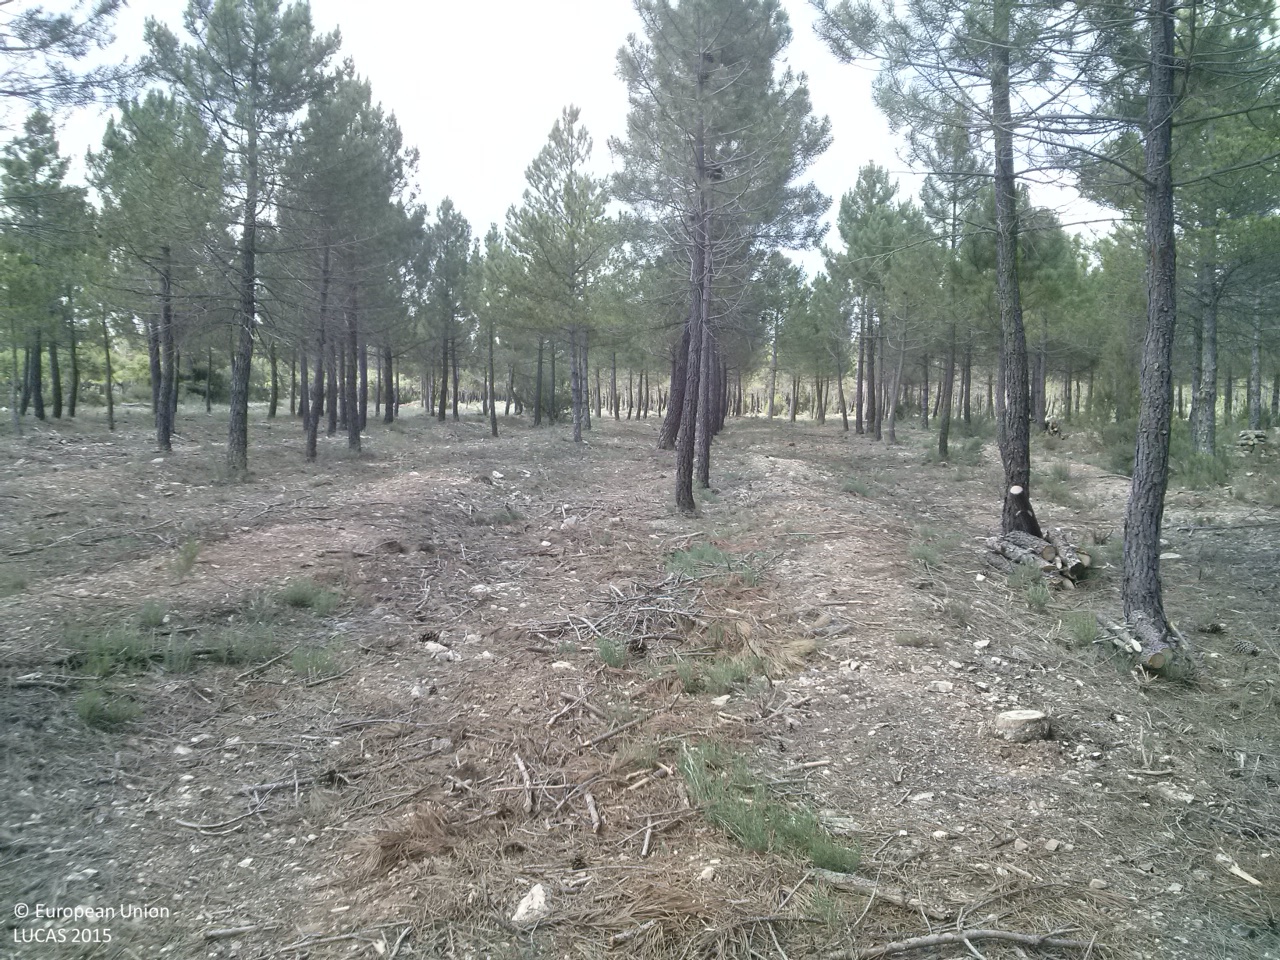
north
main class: Woodland
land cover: Pine dominated coniferous woodland
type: coniferous forest of the mediterranean region
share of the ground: 25 - 50 %
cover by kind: coniferous forest trees 50 %, herbaceous plants 20 %, unconsolidated bare surface 20 %, shrubs 10 %
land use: Forestry
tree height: > 5 m
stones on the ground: 25 - 50 %
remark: Clear cut
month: June
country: ES
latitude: 39.6770
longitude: -1.6776
